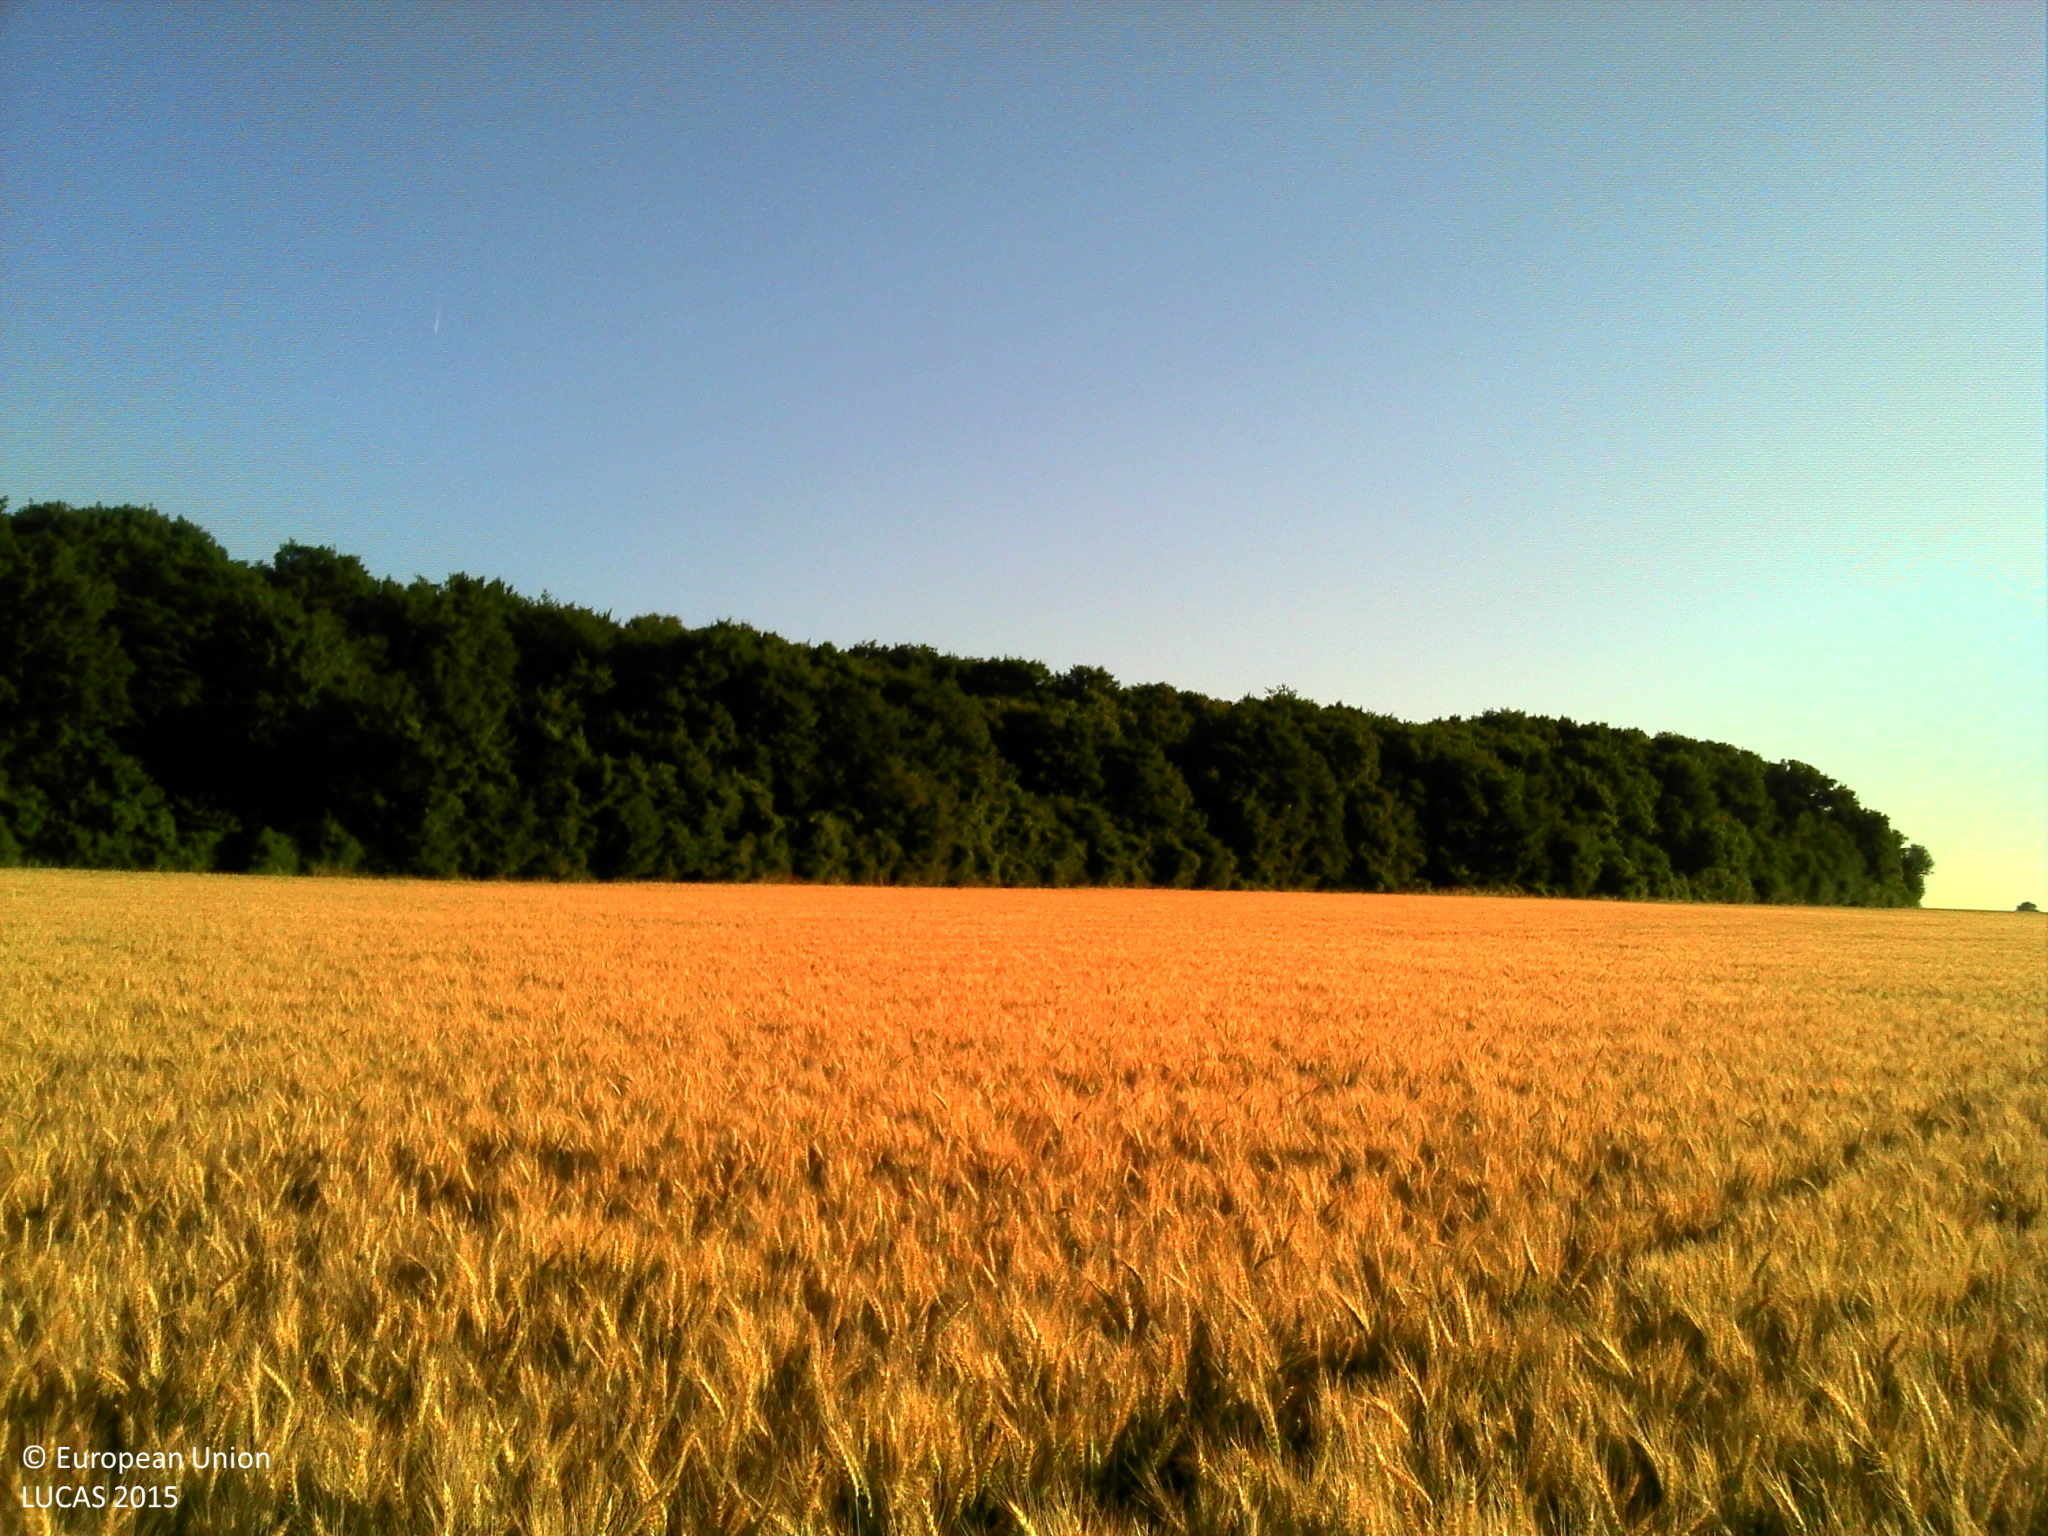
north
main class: Cropland
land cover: Common wheat
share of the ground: > 75 %
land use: Agriculture (excluding fallow land and kitchen gardens)
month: June
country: FR
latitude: 49.4277
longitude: 2.4459
